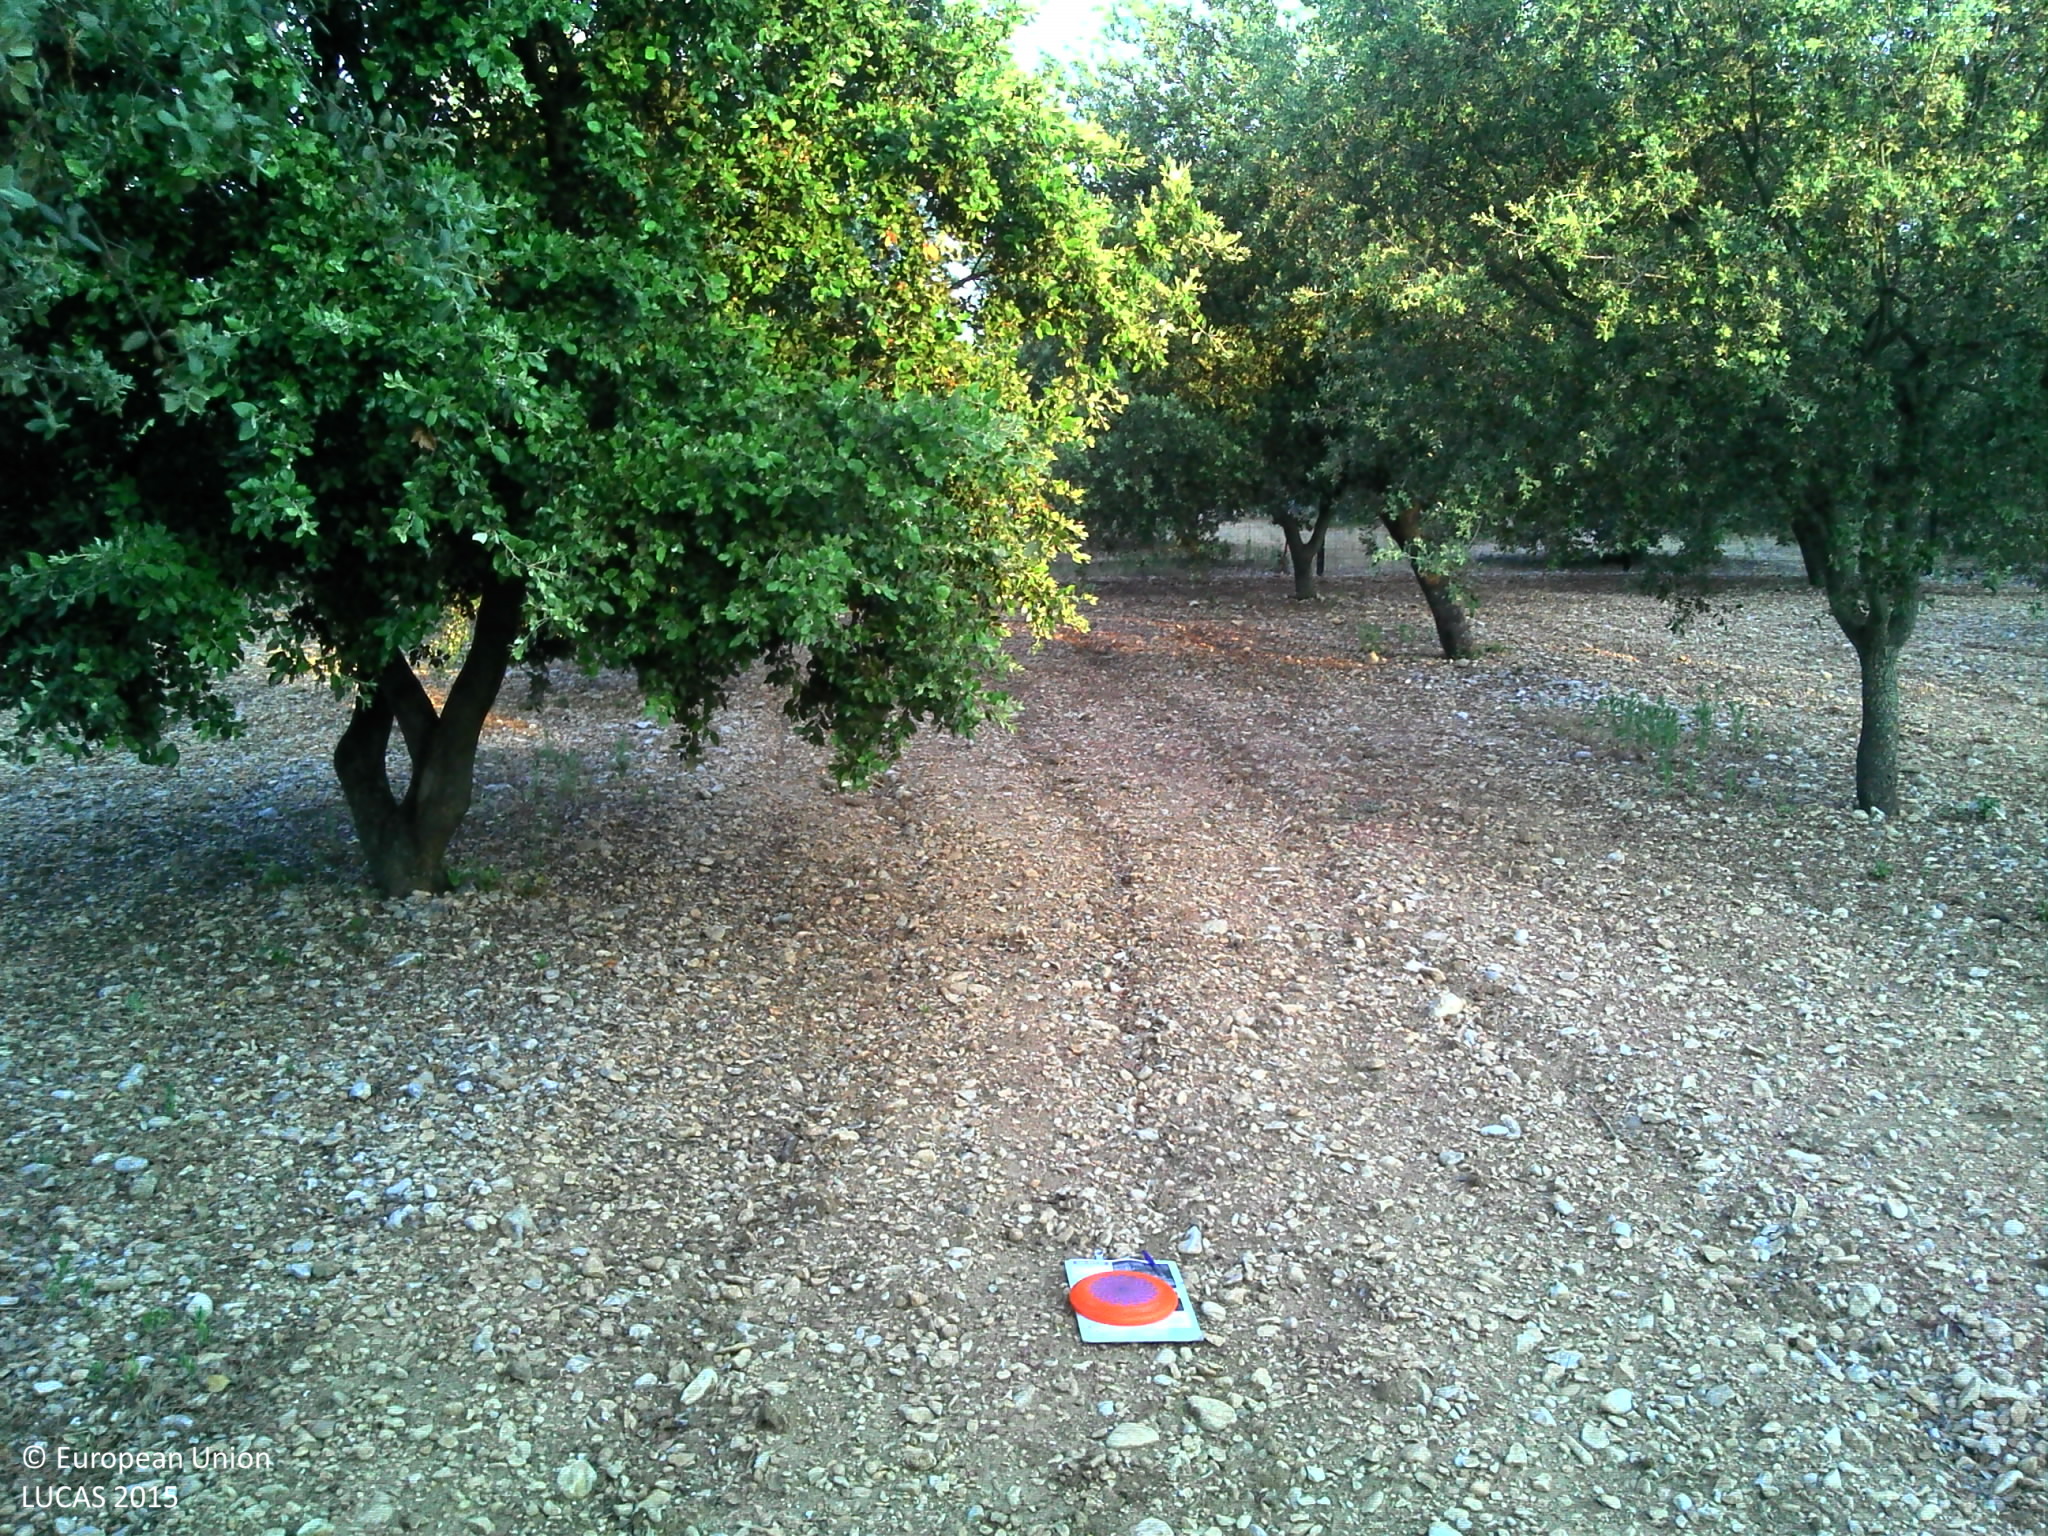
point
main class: Cropland
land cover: Pear fruit
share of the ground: 25 - 50 %
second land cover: Other bare soil
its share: > 75 %
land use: Agriculture (excluding fallow land and kitchen gardens)
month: July
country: FR
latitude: 44.0159
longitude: 5.0561
